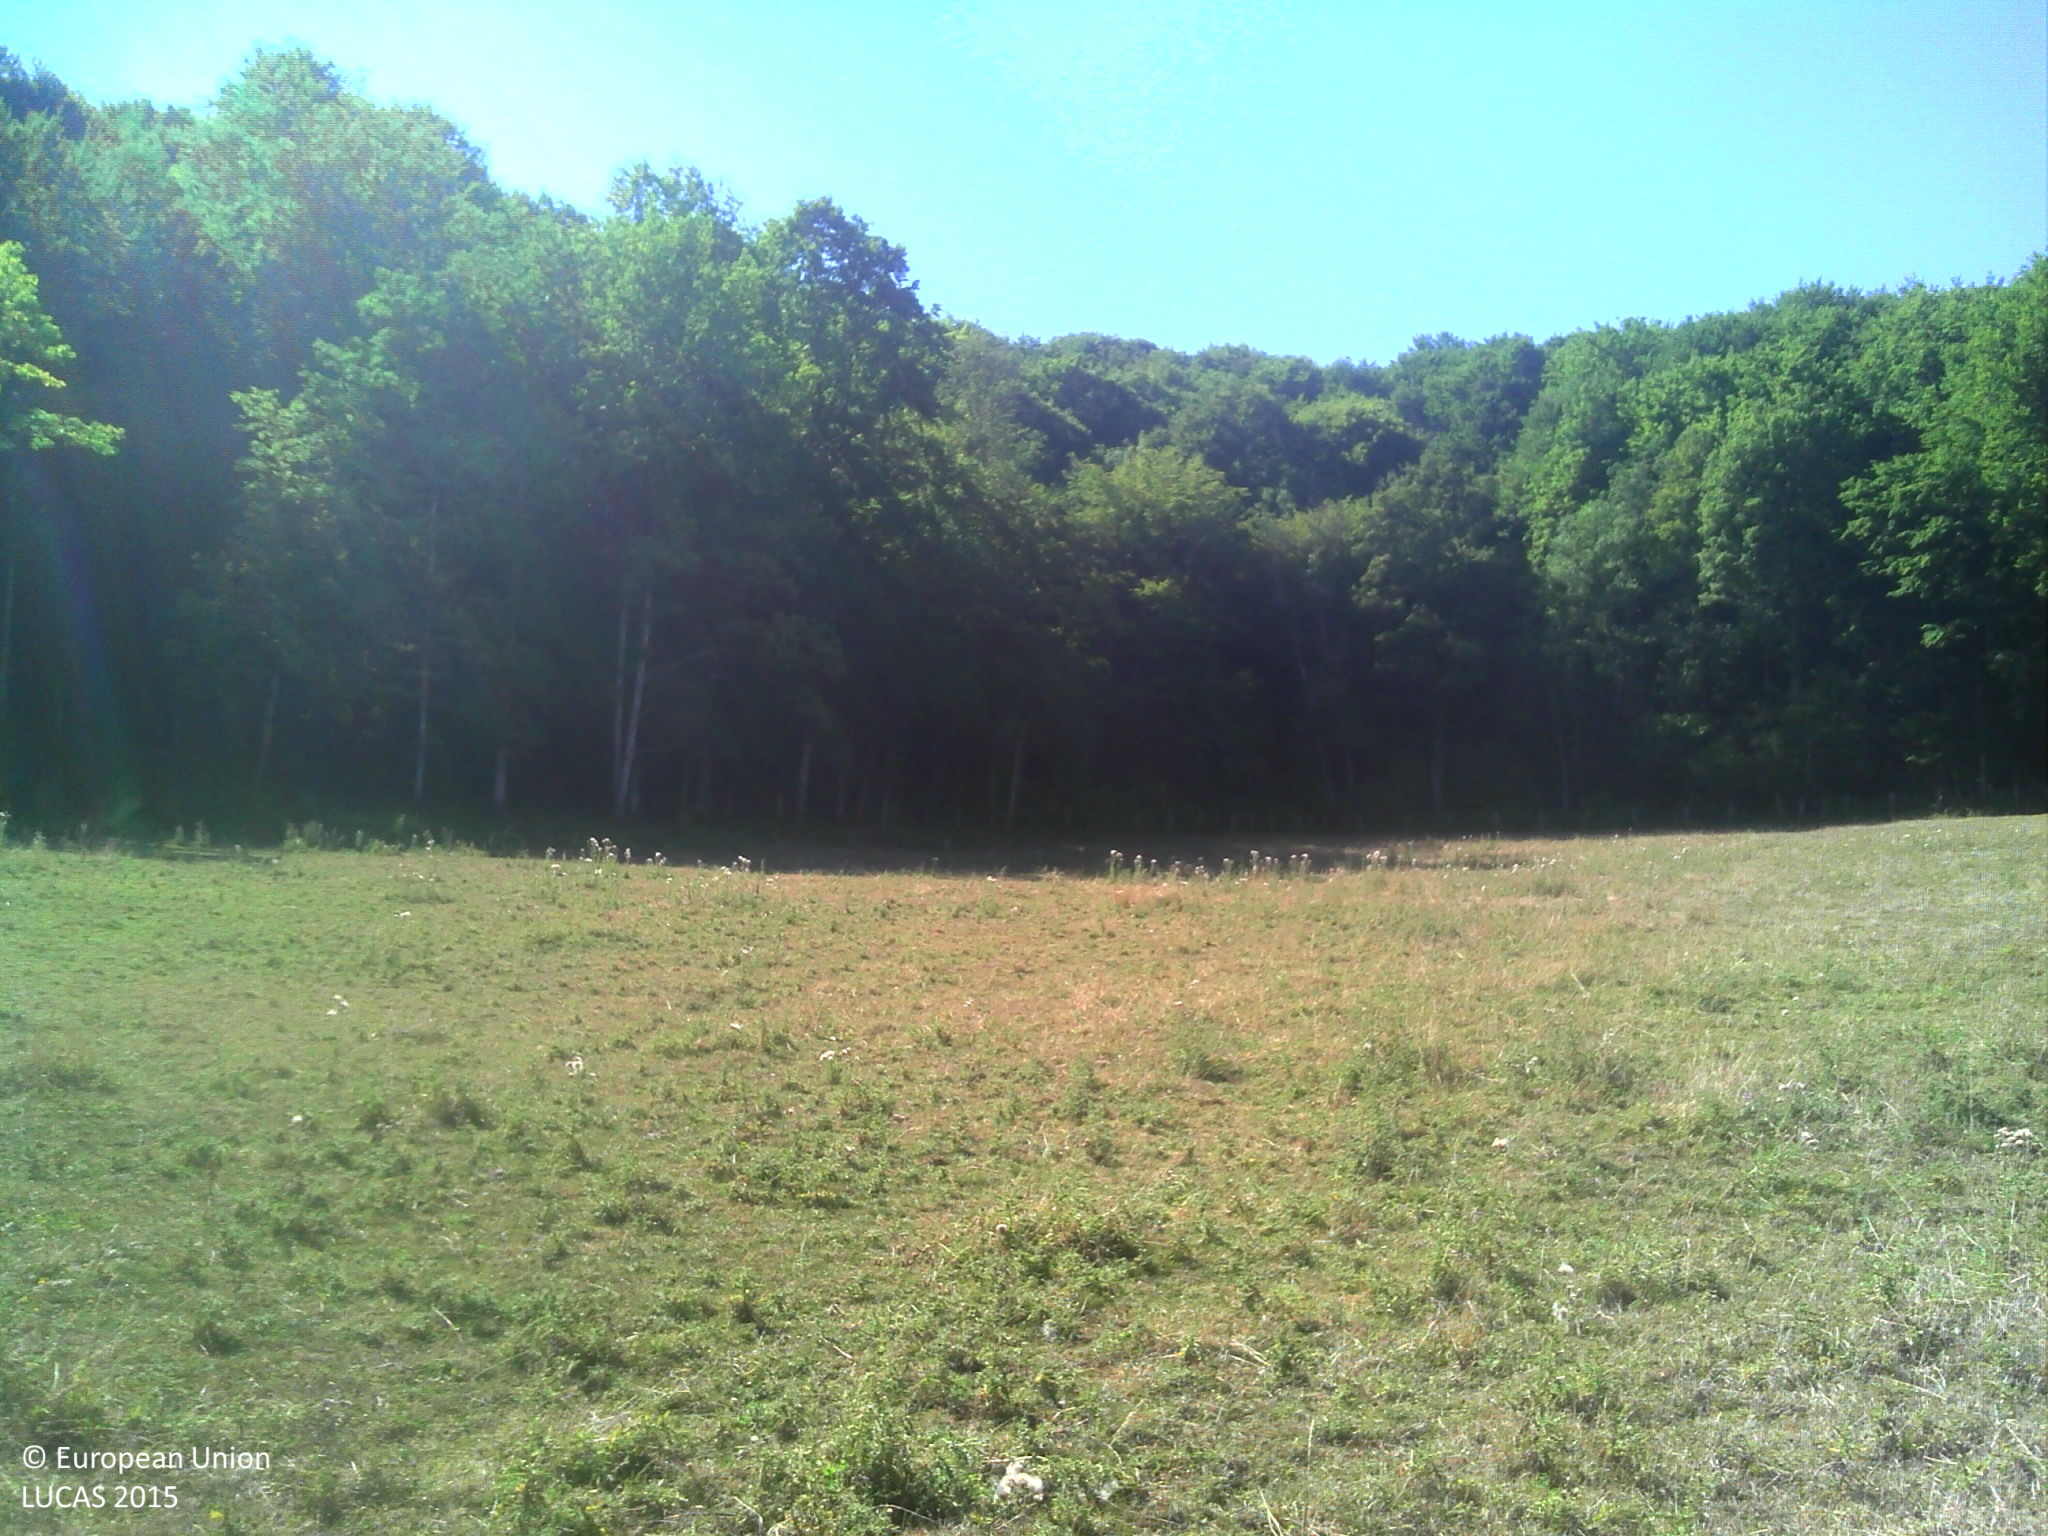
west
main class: Grassland
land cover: Grassland without tree/shrub cover
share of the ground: > 75 %
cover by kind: herbaceous plants 100 %
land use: Agriculture (excluding fallow land and kitchen gardens)
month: August
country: FR
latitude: 47.7531
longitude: 5.0776
